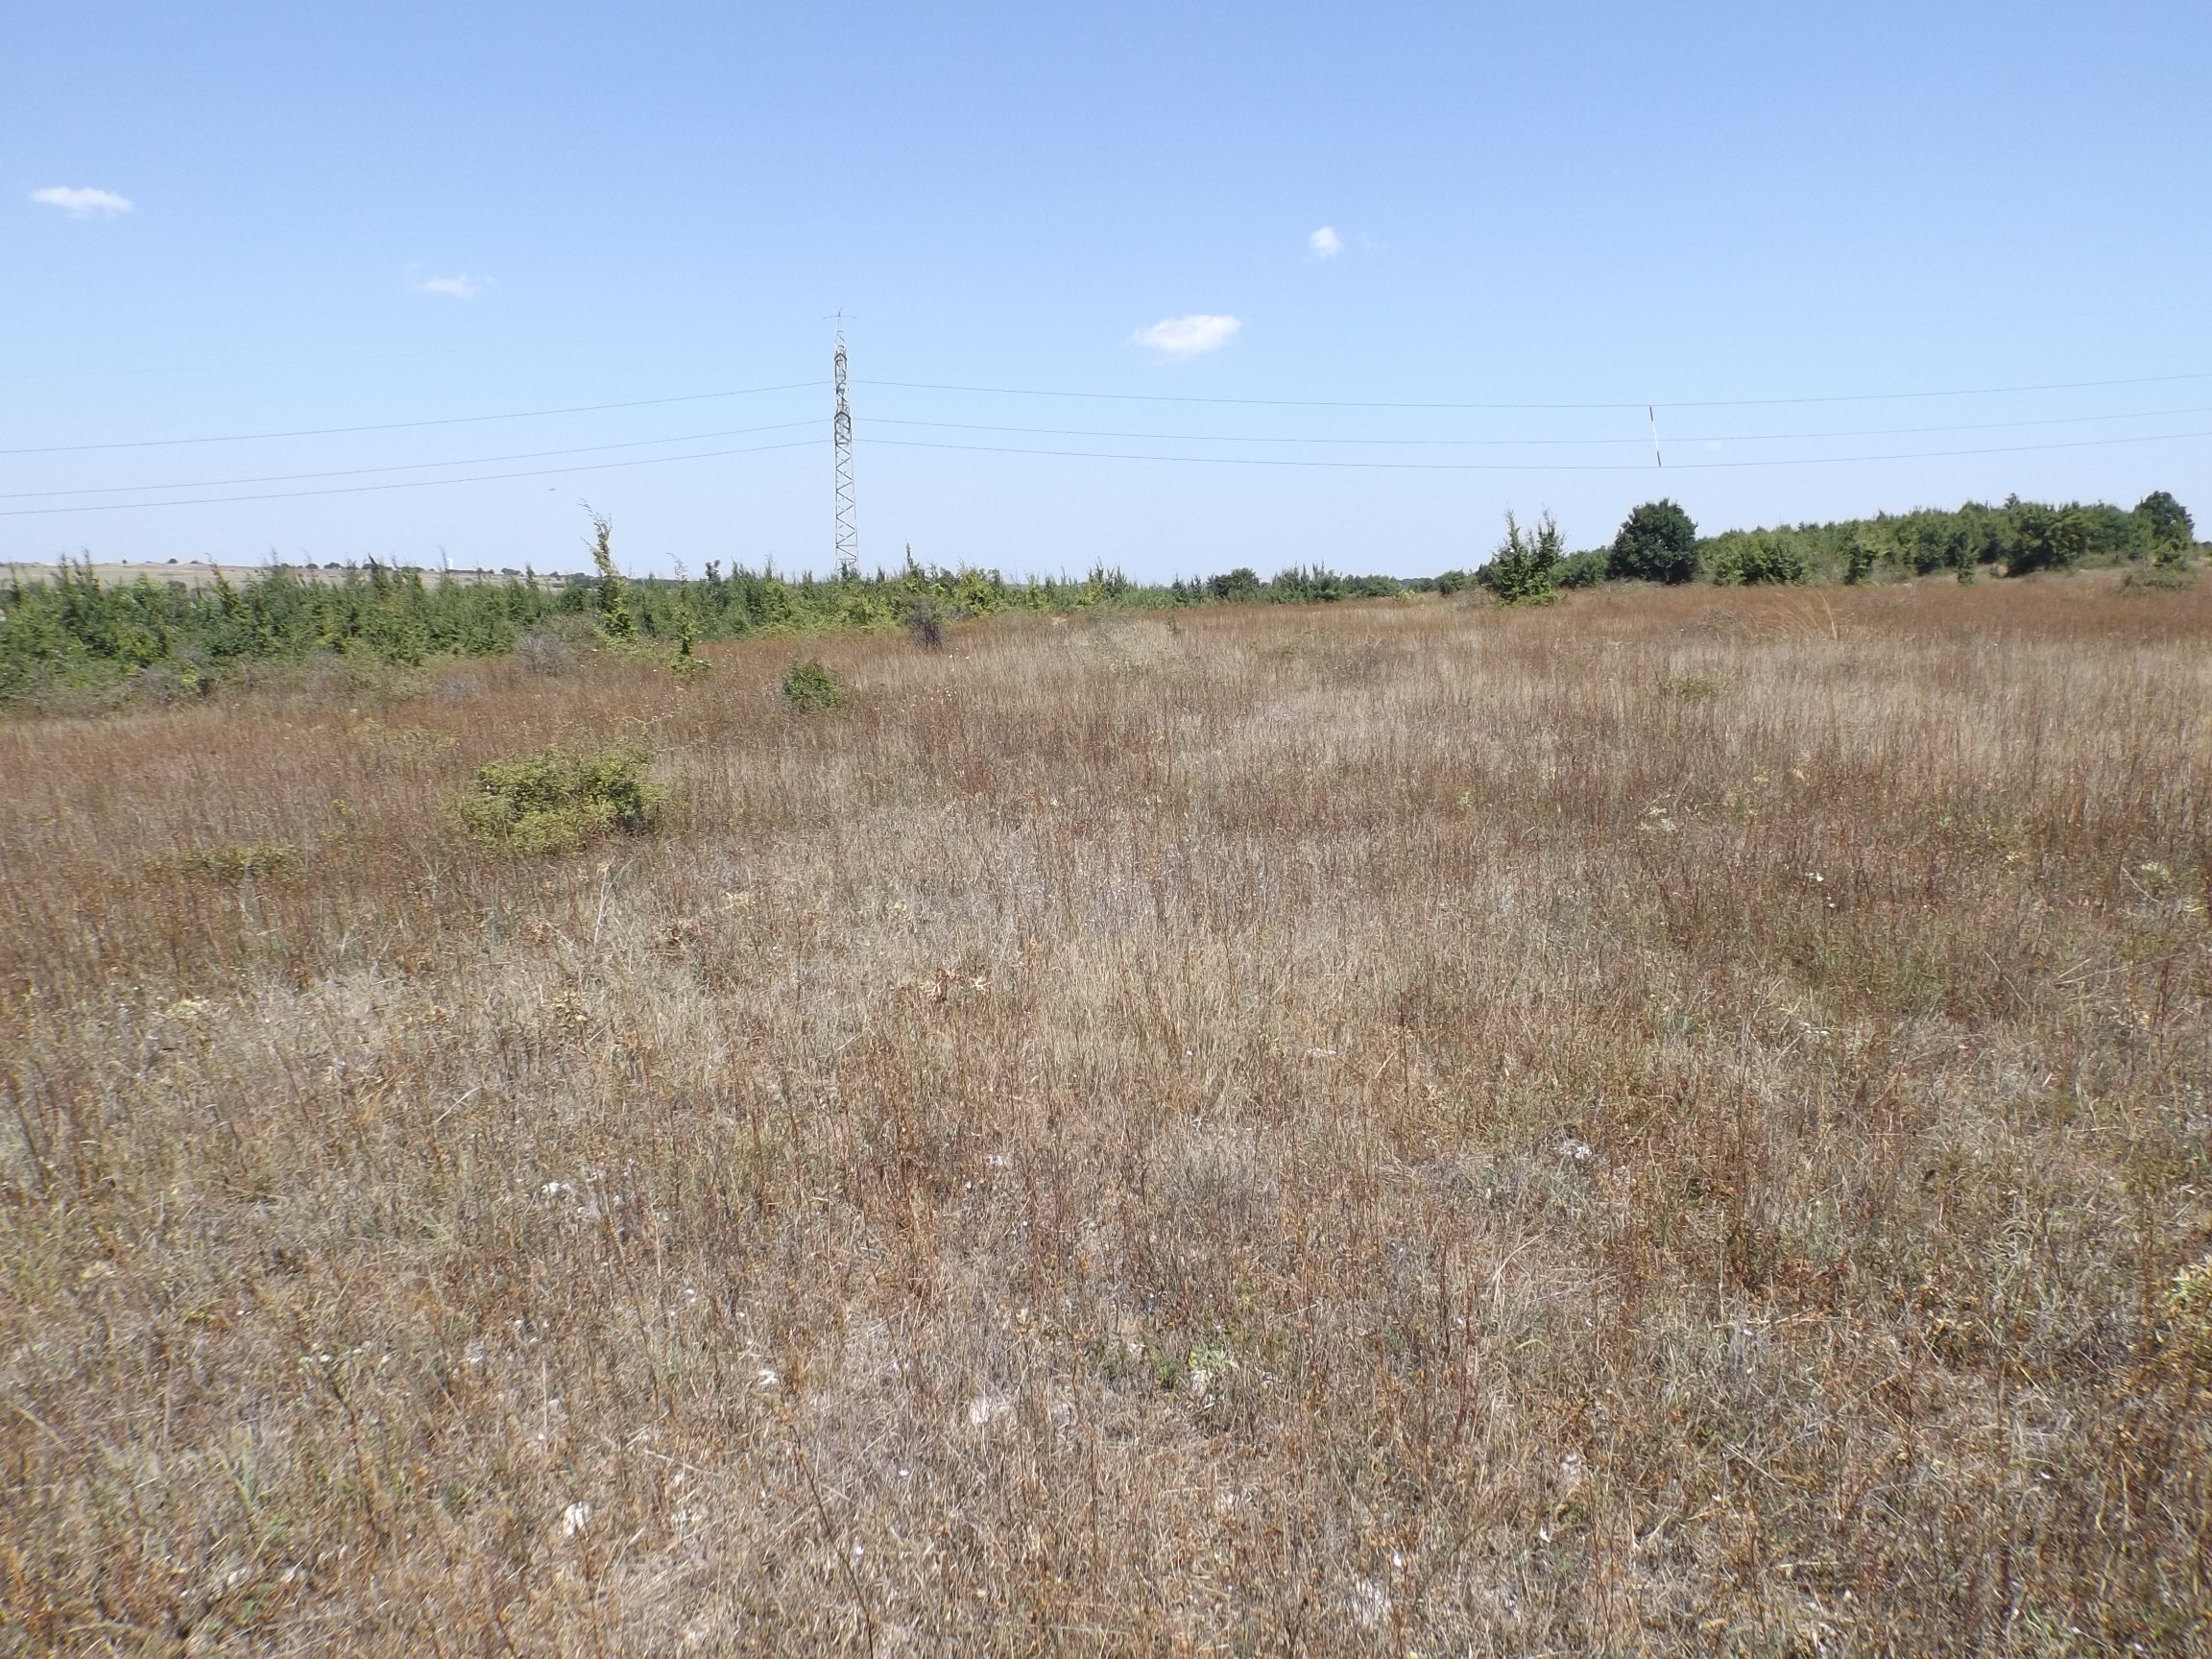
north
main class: Grassland
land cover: Grassland without tree/shrub cover
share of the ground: > 75 %
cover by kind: herbaceous plants 100 %
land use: Semi-natural and natural areas not in use
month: August
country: BG
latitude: 43.2600
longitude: 27.9921
